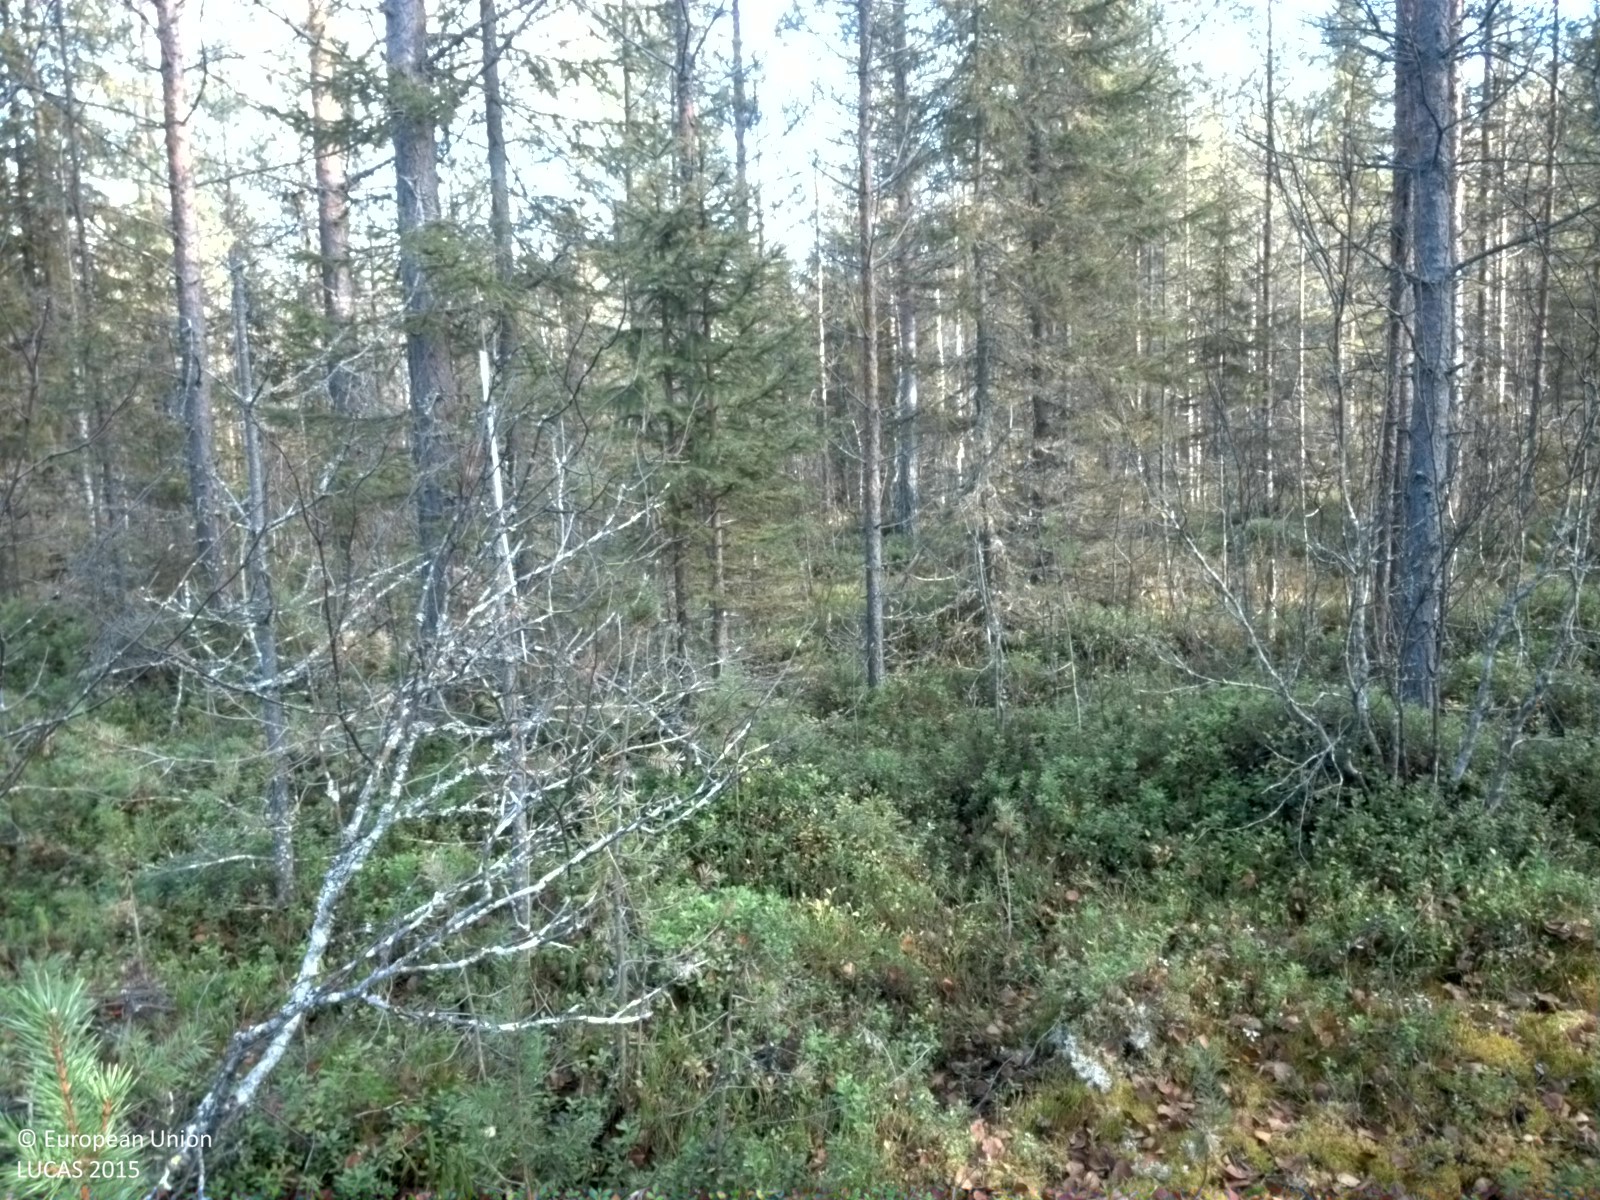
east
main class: Woodland
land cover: Pine dominated coniferous woodland
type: boreal forest
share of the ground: 25 - 50 %
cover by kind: shrubs 60 %, coniferous forest trees 35 %, broadleaved forest trees 5 %
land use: Forestry
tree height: > 5 m
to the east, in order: Pine dominated coniferous woodland; Pine dominated mixed woodland; Spruce dominated coniferous woodland; Rivers and streams; Spruce dominated mixed woodland; Grassland with sparse tree/shrub cover
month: October
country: SE
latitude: 65.9587
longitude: 22.2286
